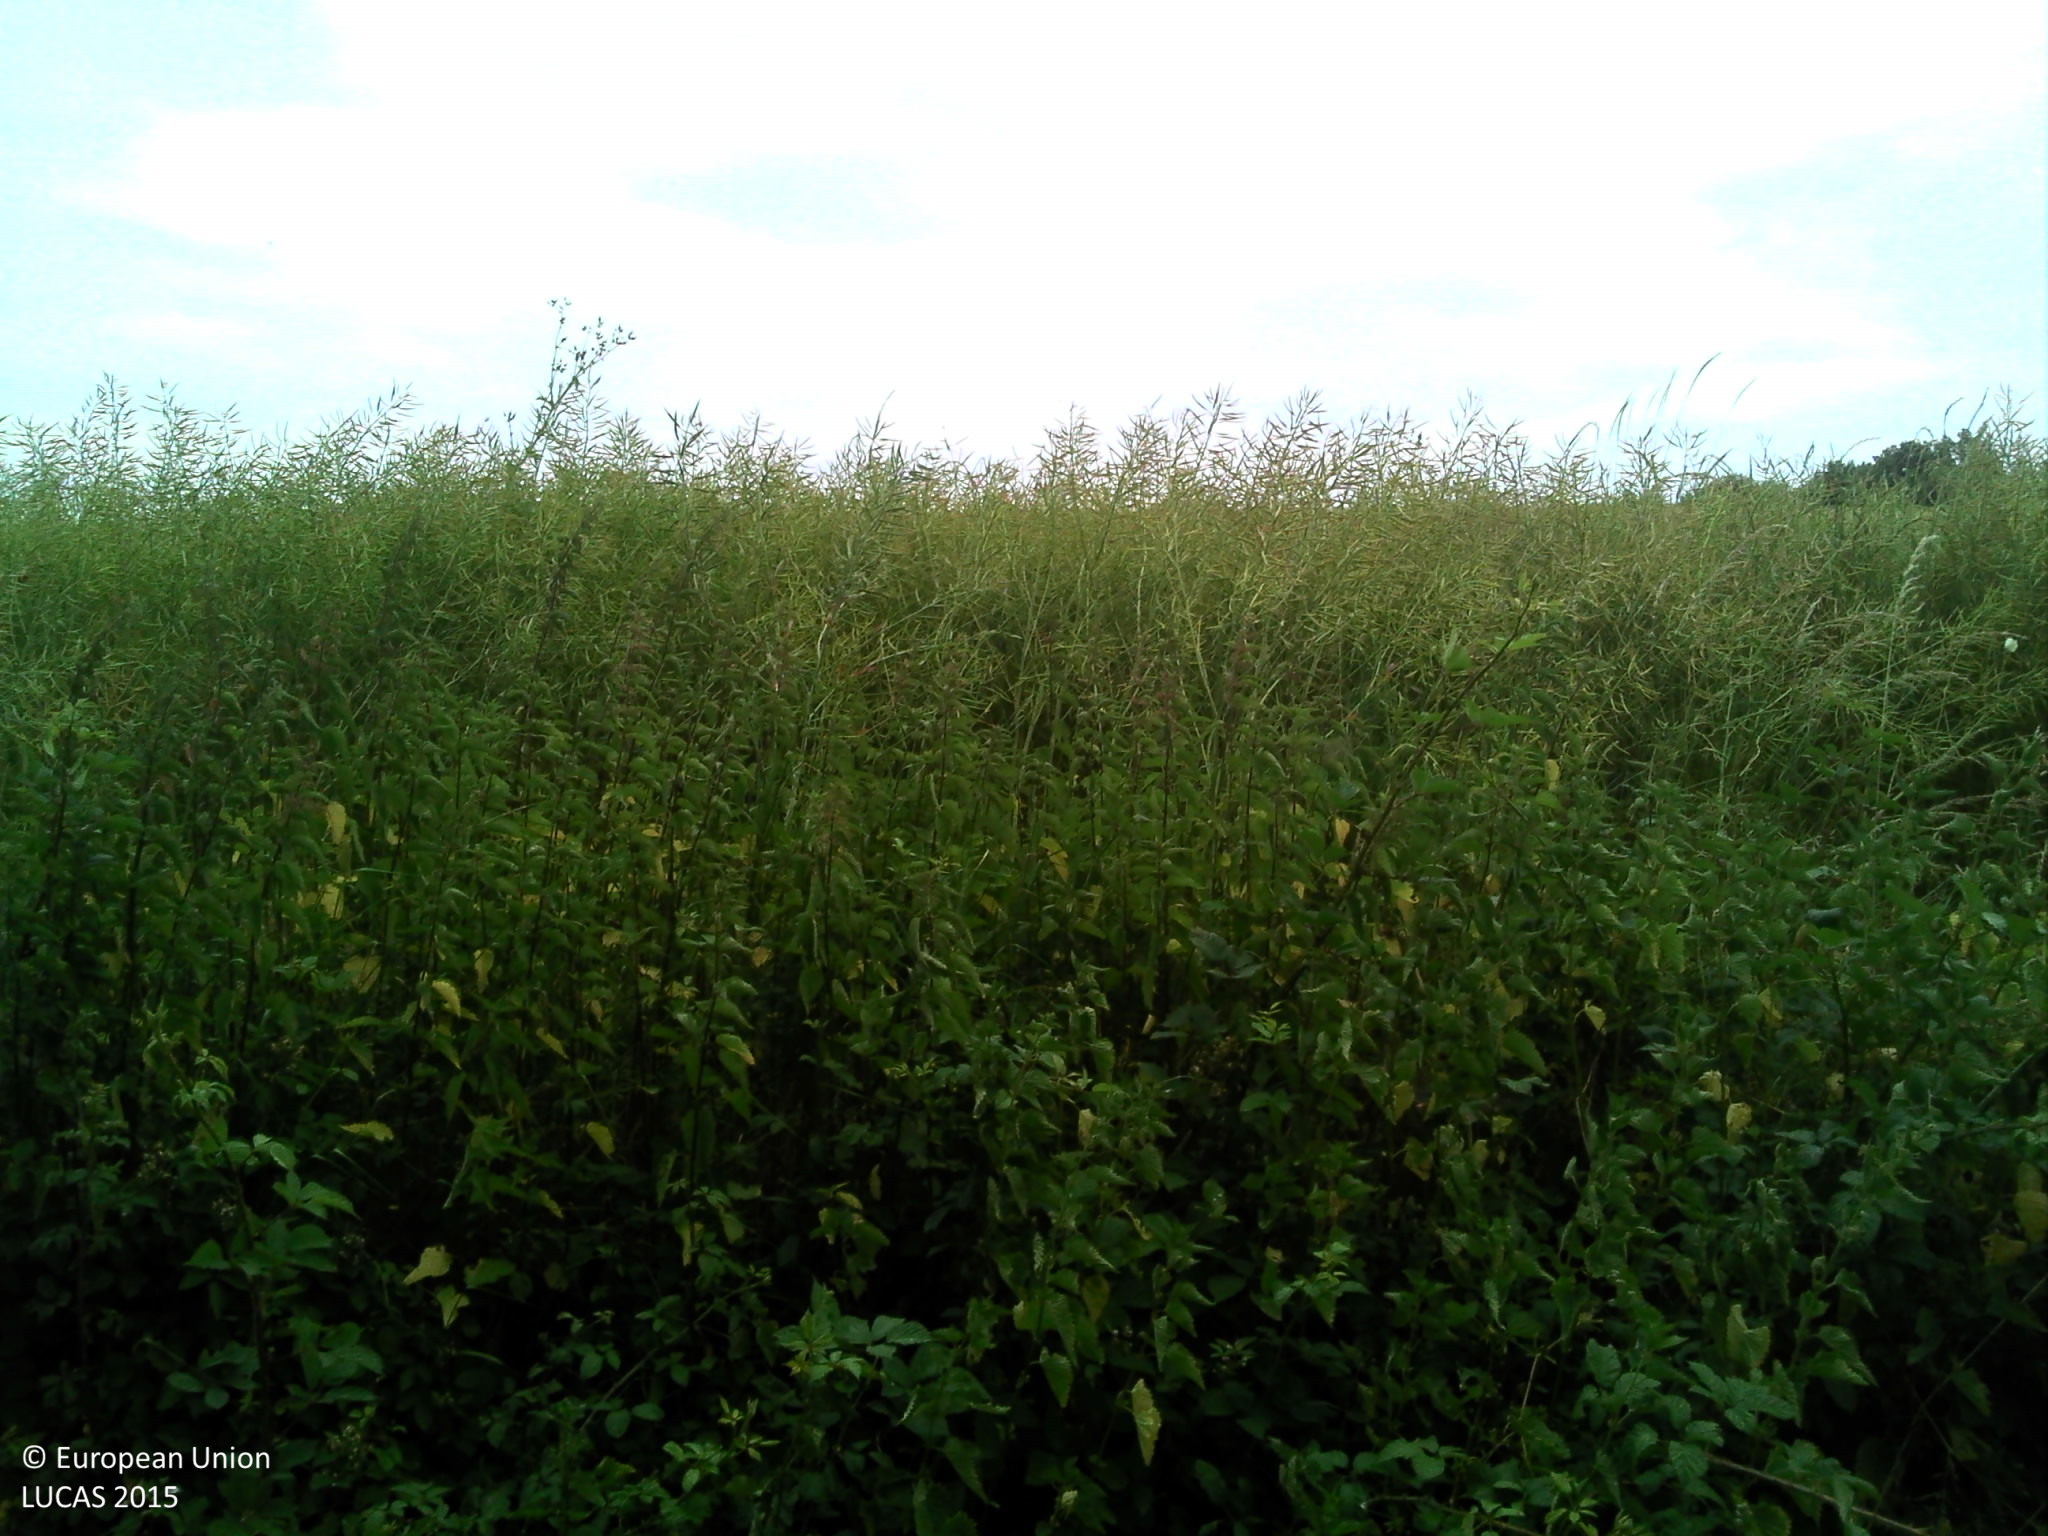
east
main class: Cropland
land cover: Rape and turnip rape
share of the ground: > 75 %
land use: Agriculture (excluding fallow land and kitchen gardens)
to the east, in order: Rape and turnip rape
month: June
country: FR
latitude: 46.1221
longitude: 4.9170
